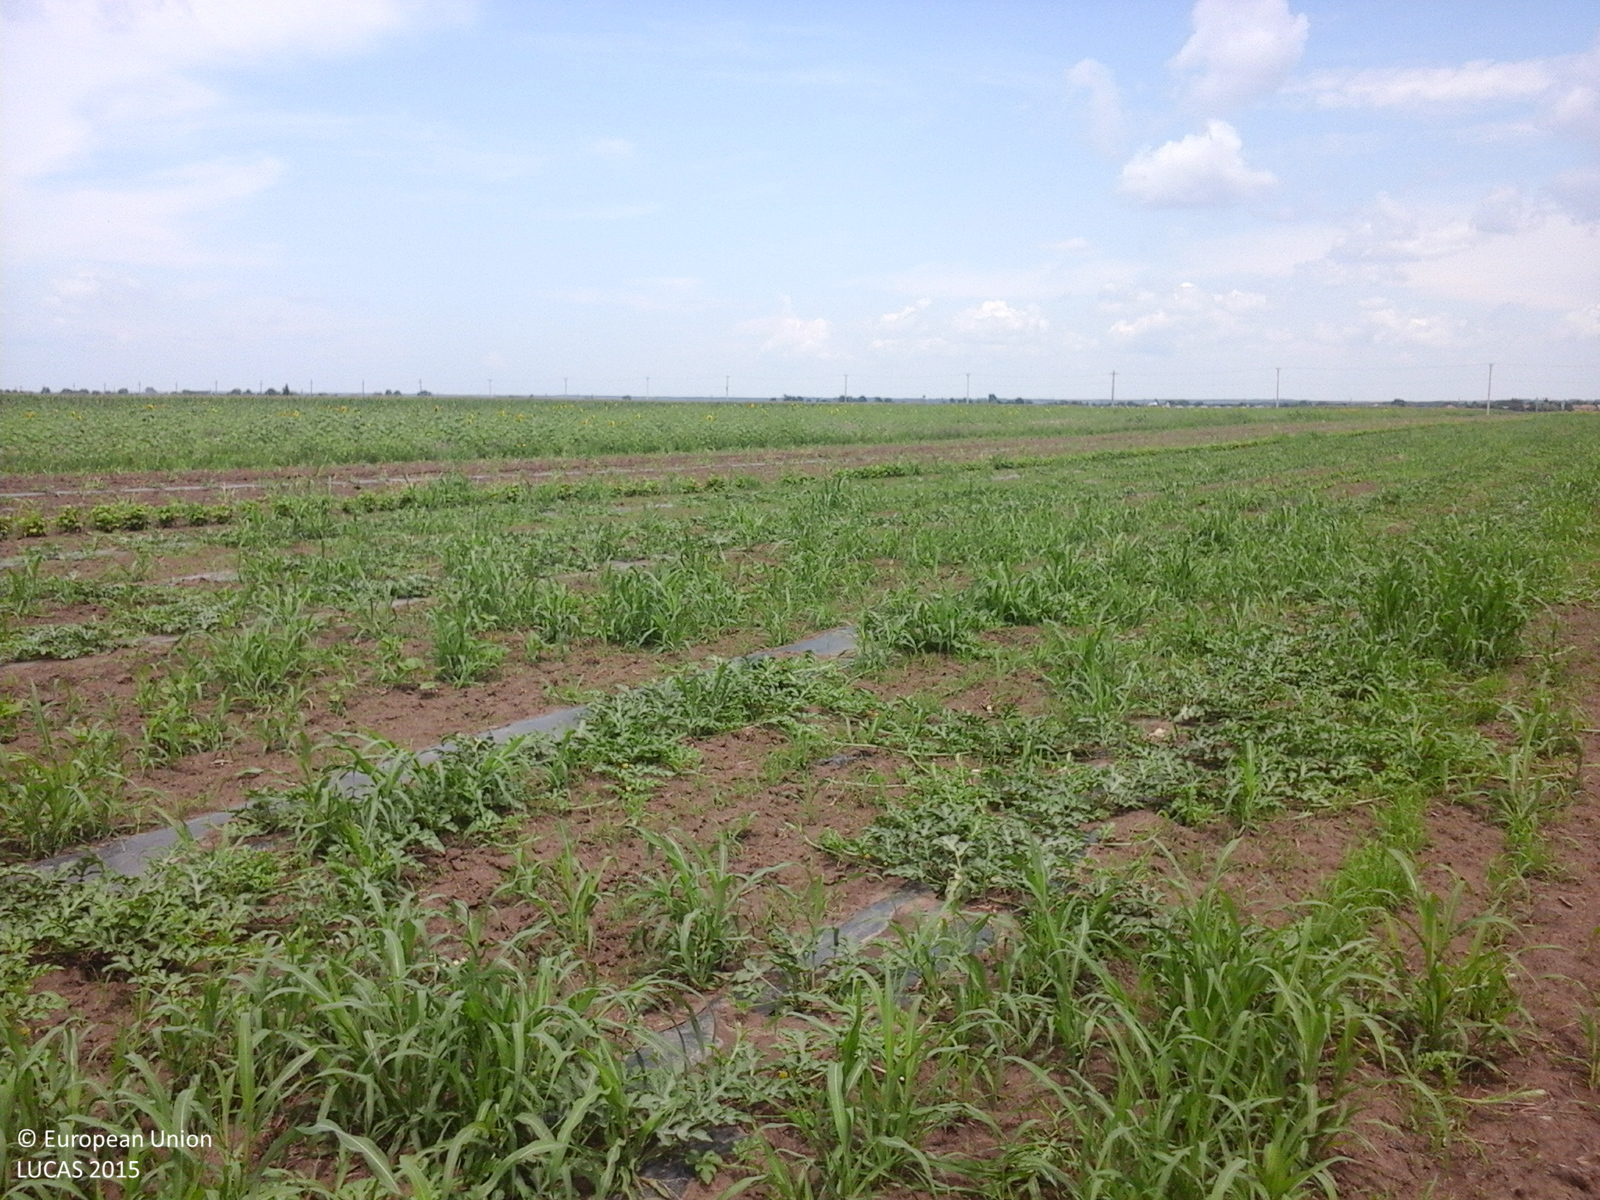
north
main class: Cropland
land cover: Other fresh vegetables
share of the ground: 50 - 75 %
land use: Agriculture (excluding fallow land and kitchen gardens)
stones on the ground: < 10 %
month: July
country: RO
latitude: 44.0530
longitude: 24.5343
